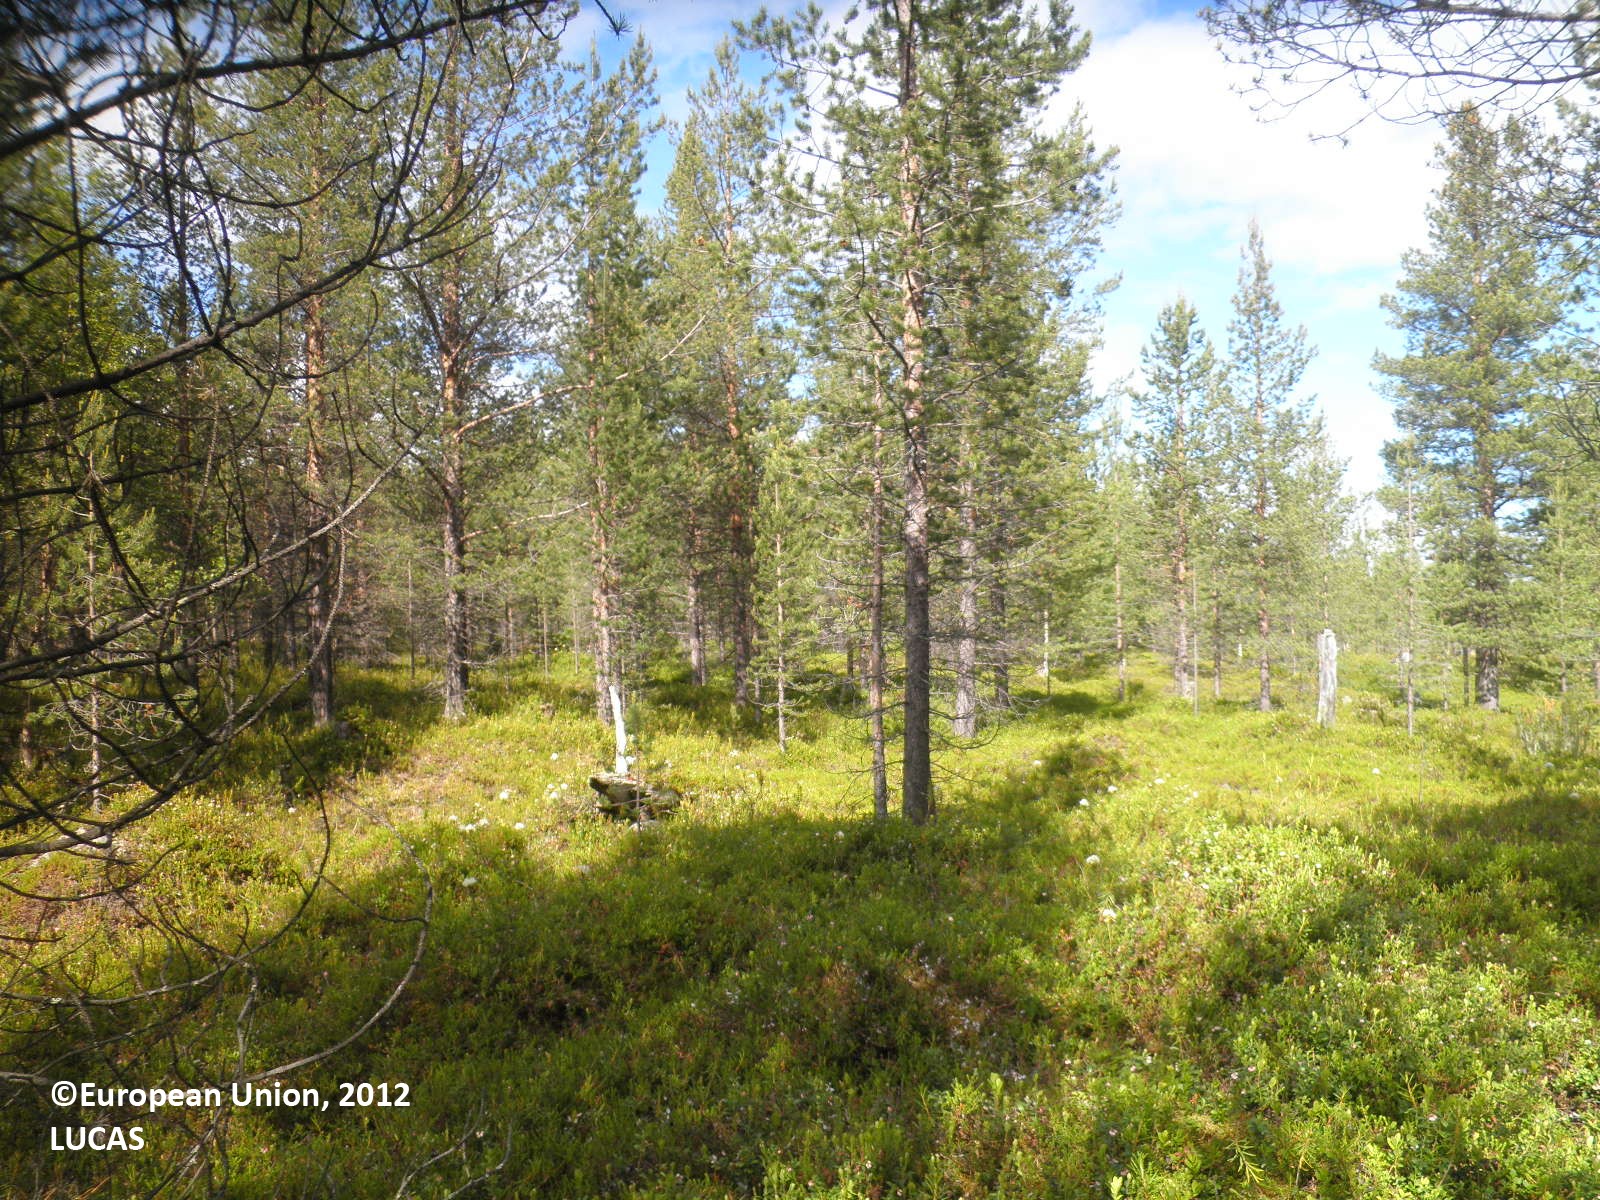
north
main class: Woodland
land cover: Pine dominated coniferous woodland
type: boreal forest
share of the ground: 50 - 75 %
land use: Forestry
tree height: > 5 m
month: July
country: FI
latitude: 68.7580
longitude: 28.0208
